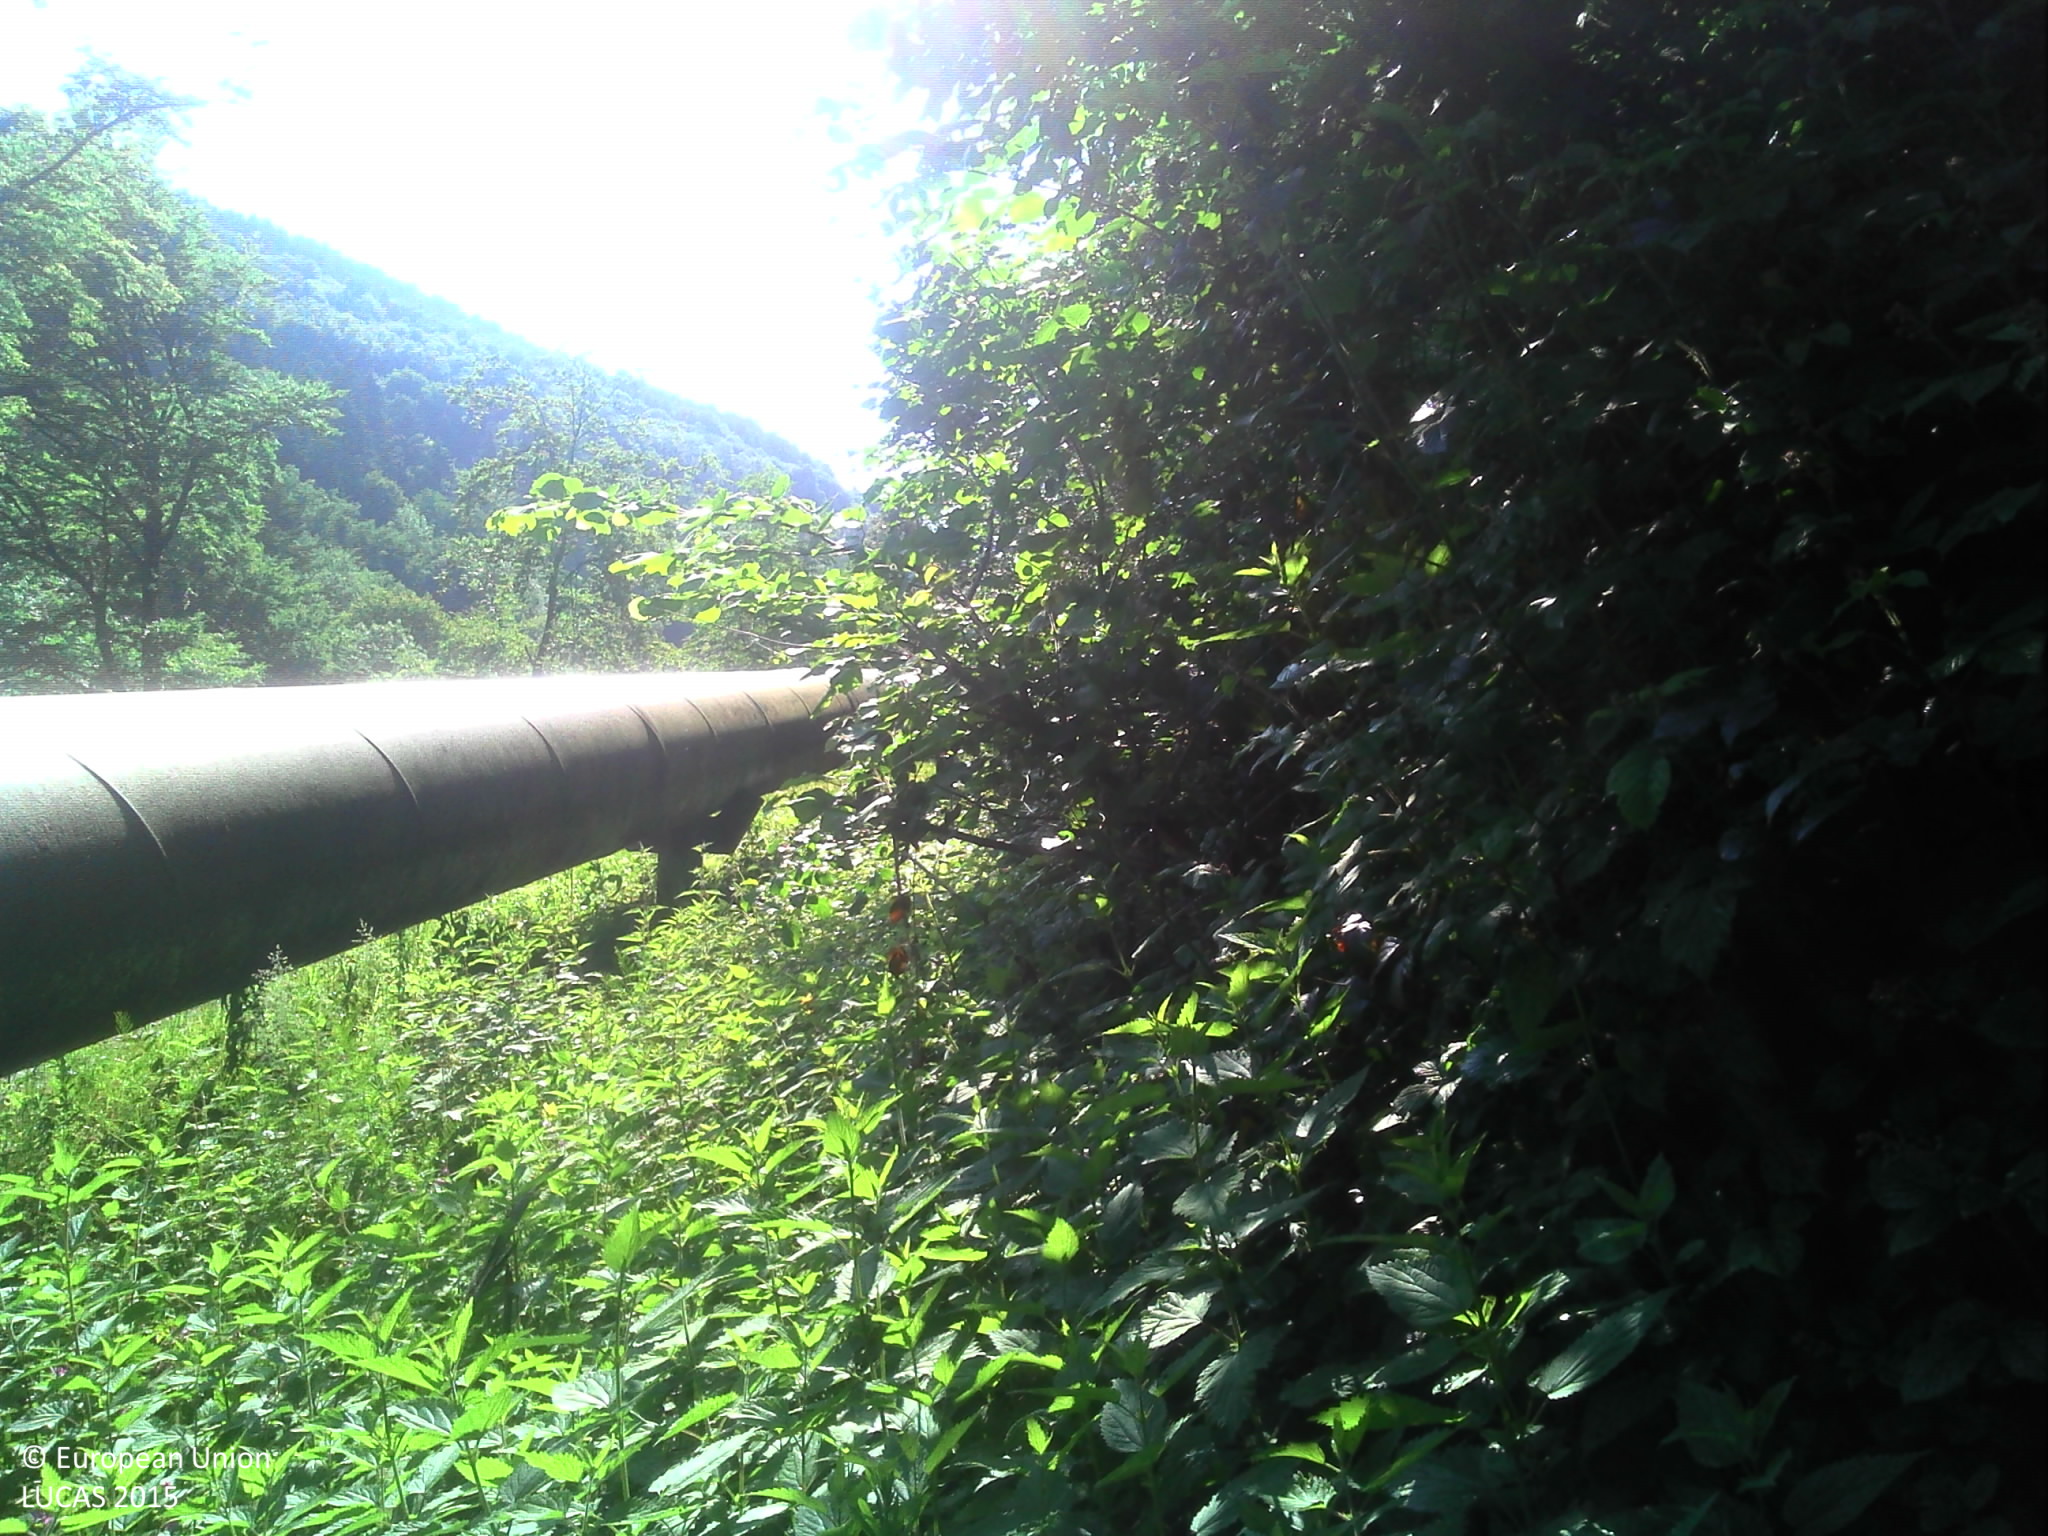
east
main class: Woodland
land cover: Broadleaved woodland
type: mesophytic deciduous forest
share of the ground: > 75 %
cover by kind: broadleaved forest trees 100 %
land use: Forestry
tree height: > 5 m
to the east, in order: Broadleaved woodland
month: June
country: FR
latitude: 43.4141
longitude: 2.0899
